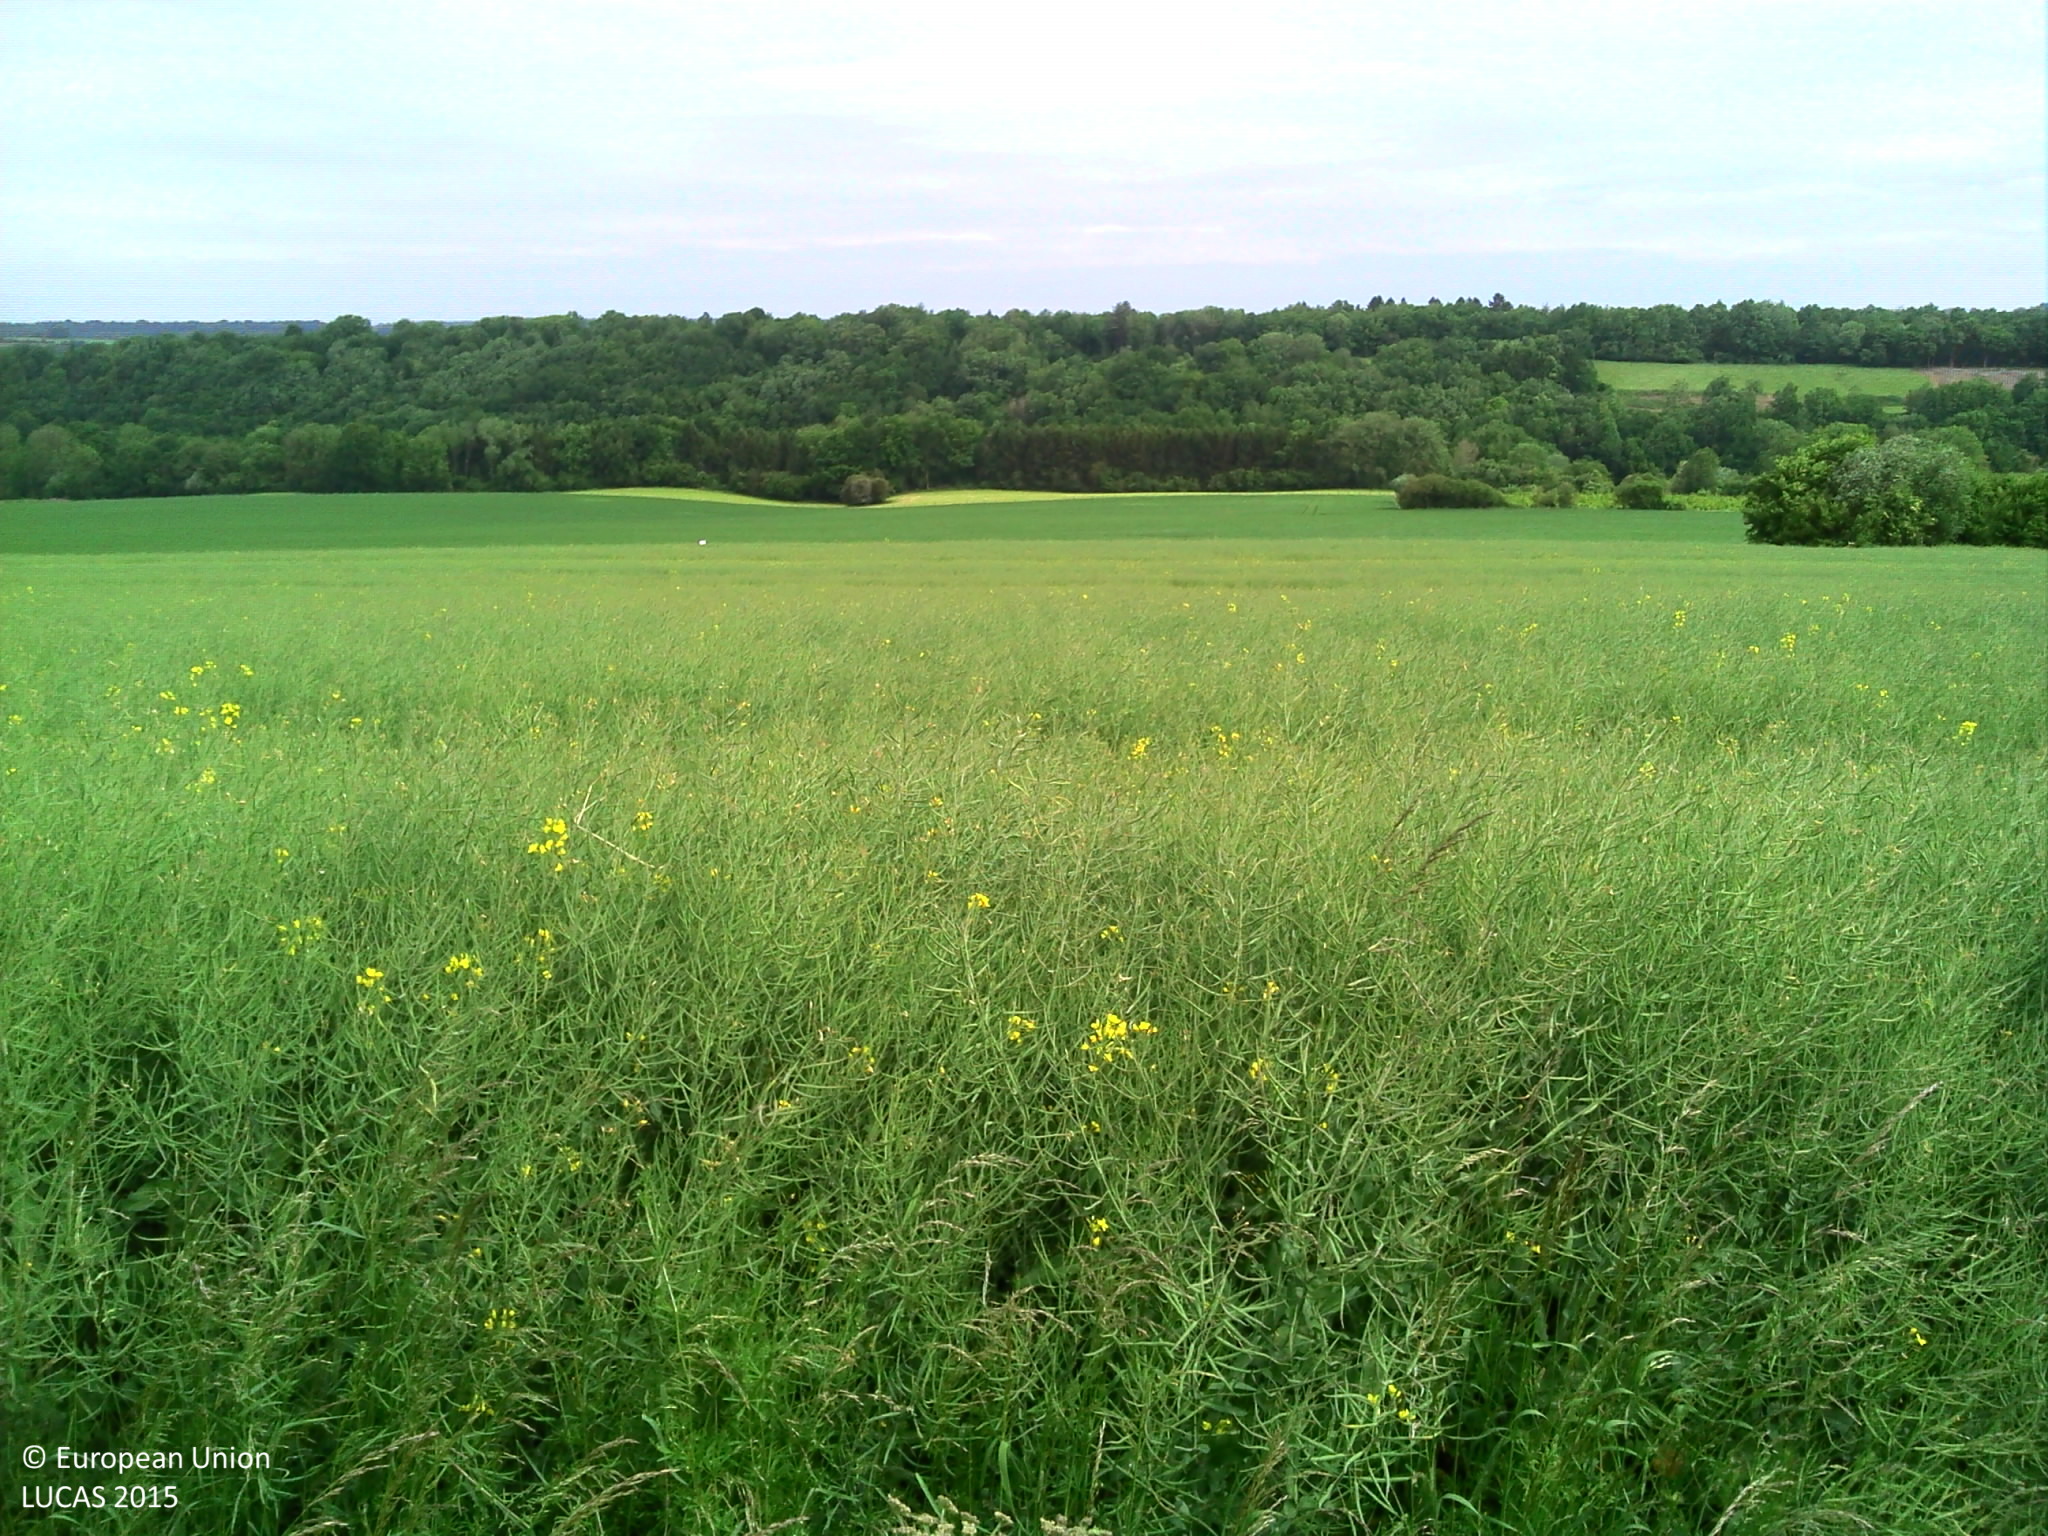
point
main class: Cropland
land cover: Rape and turnip rape
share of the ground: > 75 %
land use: Agriculture (excluding fallow land and kitchen gardens)
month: June
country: BE
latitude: 50.4412
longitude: 5.5911
